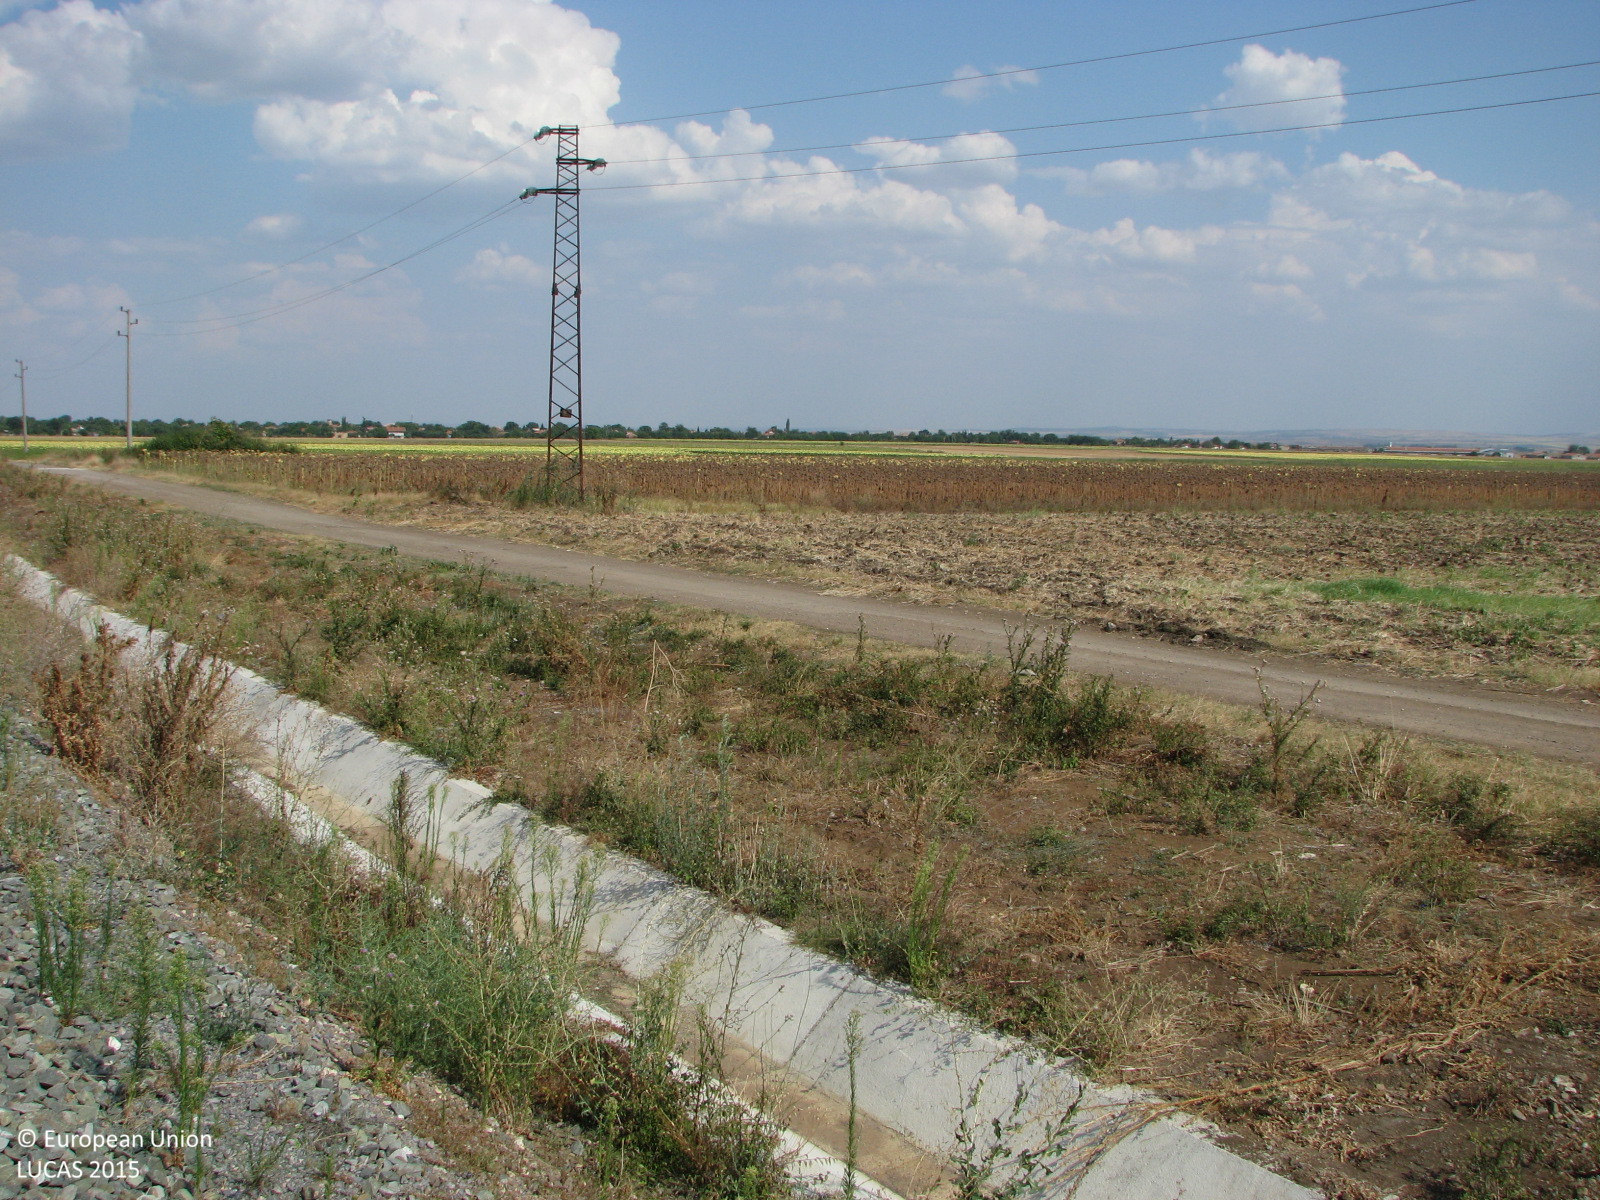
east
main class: Grassland
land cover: Spontaneously vegetated surfaces
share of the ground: > 75 %
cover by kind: herbaceous plants 100 %
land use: Railway transport
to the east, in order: Spontaneously vegetated surfaces; Railways; Grass margins; Ditches and canals; Spontaneously vegetated surfaces; Tracks; Common wheat; Electric lines; Common wheat; Sunflower; Lucerne; Spontaneously vegetated surfaces; Tracks; Spontaneously vegetated surfaces
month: August
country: BG
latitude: 42.5823
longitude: 26.5810
